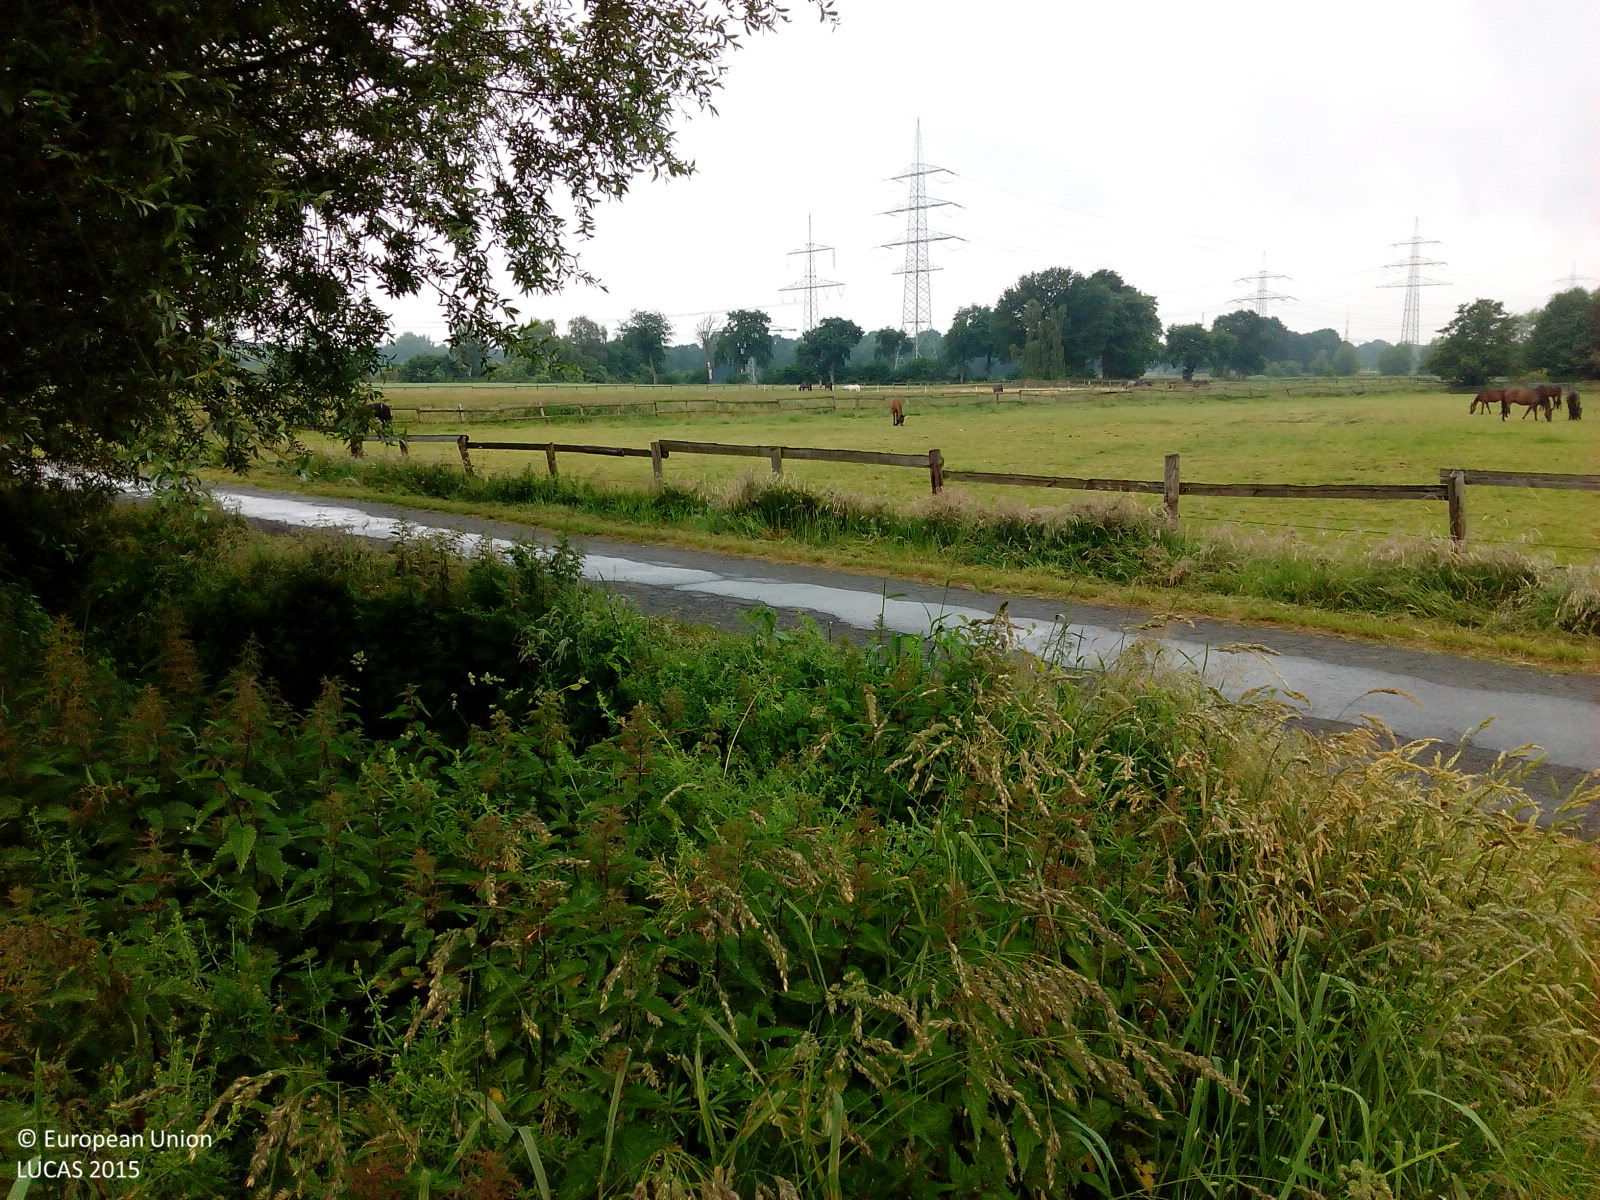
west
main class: Grassland
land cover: Grassland without tree/shrub cover
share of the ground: > 75 %
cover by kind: herbaceous plants 100 %
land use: Agriculture (excluding fallow land and kitchen gardens)
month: June
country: DE
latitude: 51.6398
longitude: 7.0667
